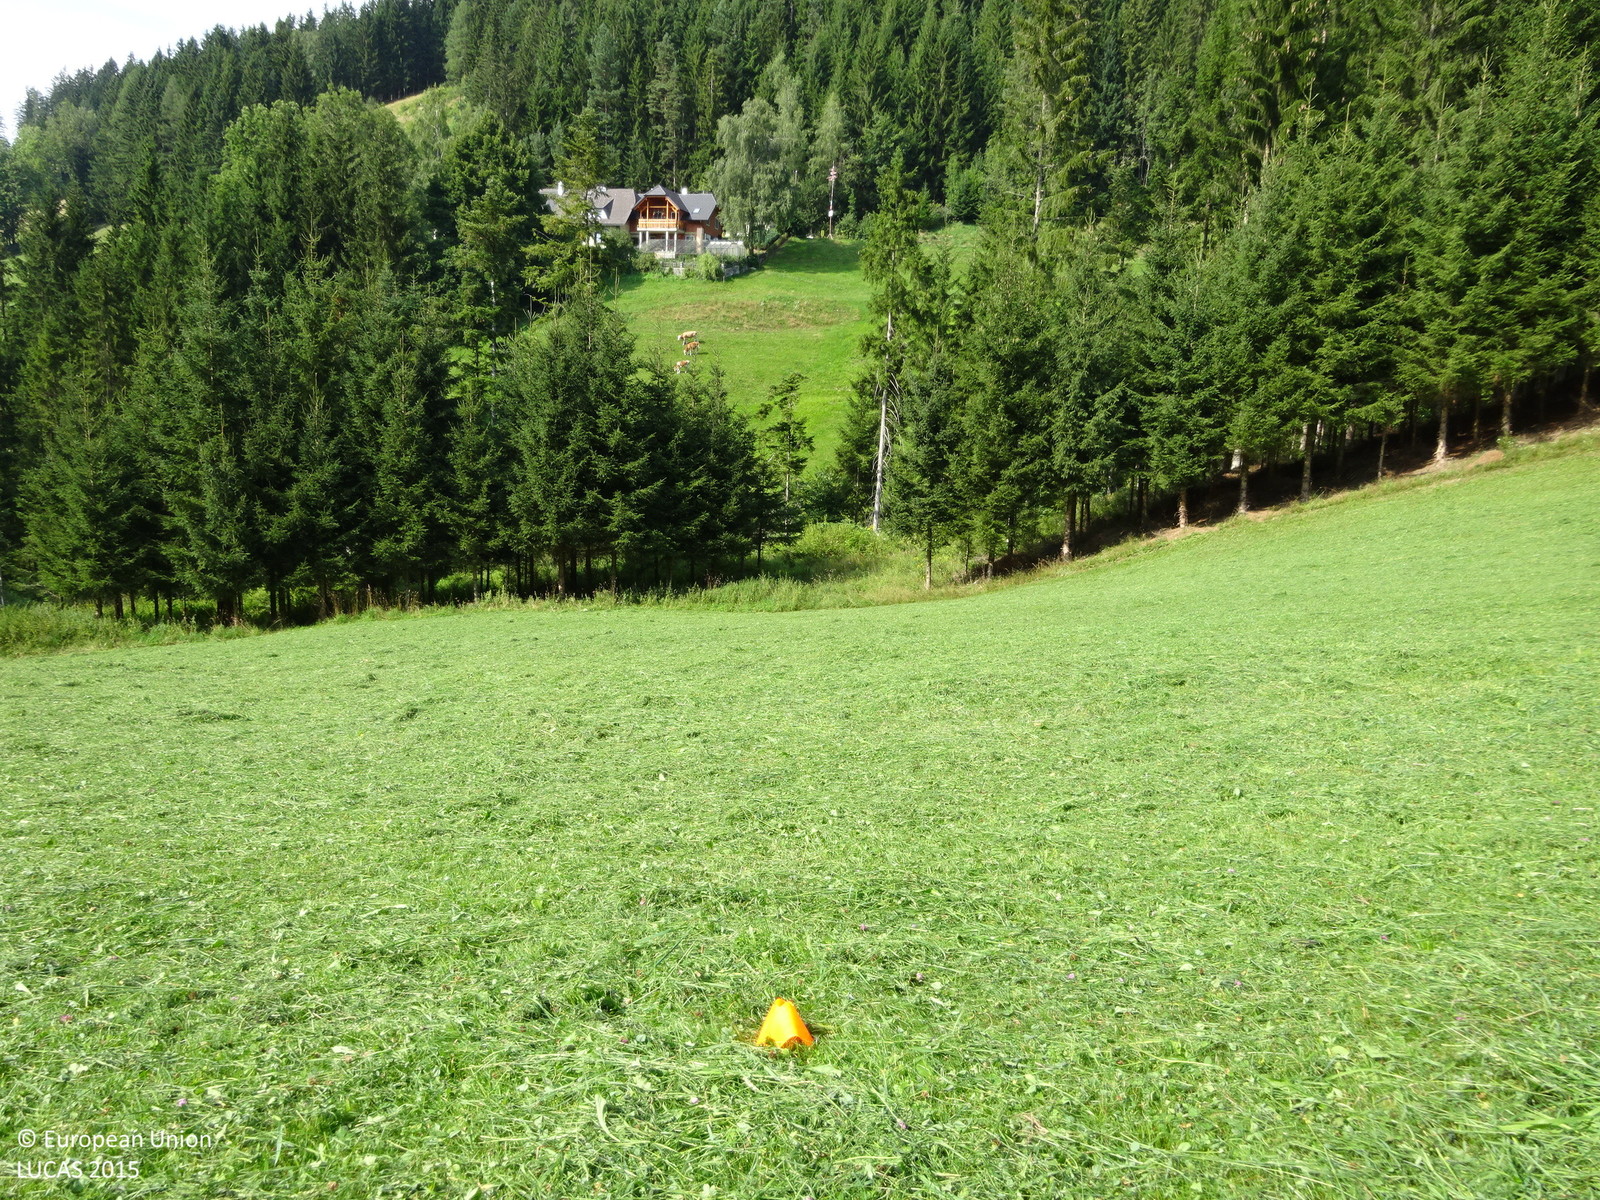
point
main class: Grassland
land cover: Grassland without tree/shrub cover
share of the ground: > 75 %
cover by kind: herbaceous plants 100 %
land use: Agriculture (excluding fallow land and kitchen gardens)
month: August
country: AT
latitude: 47.4438
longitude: 15.7168
